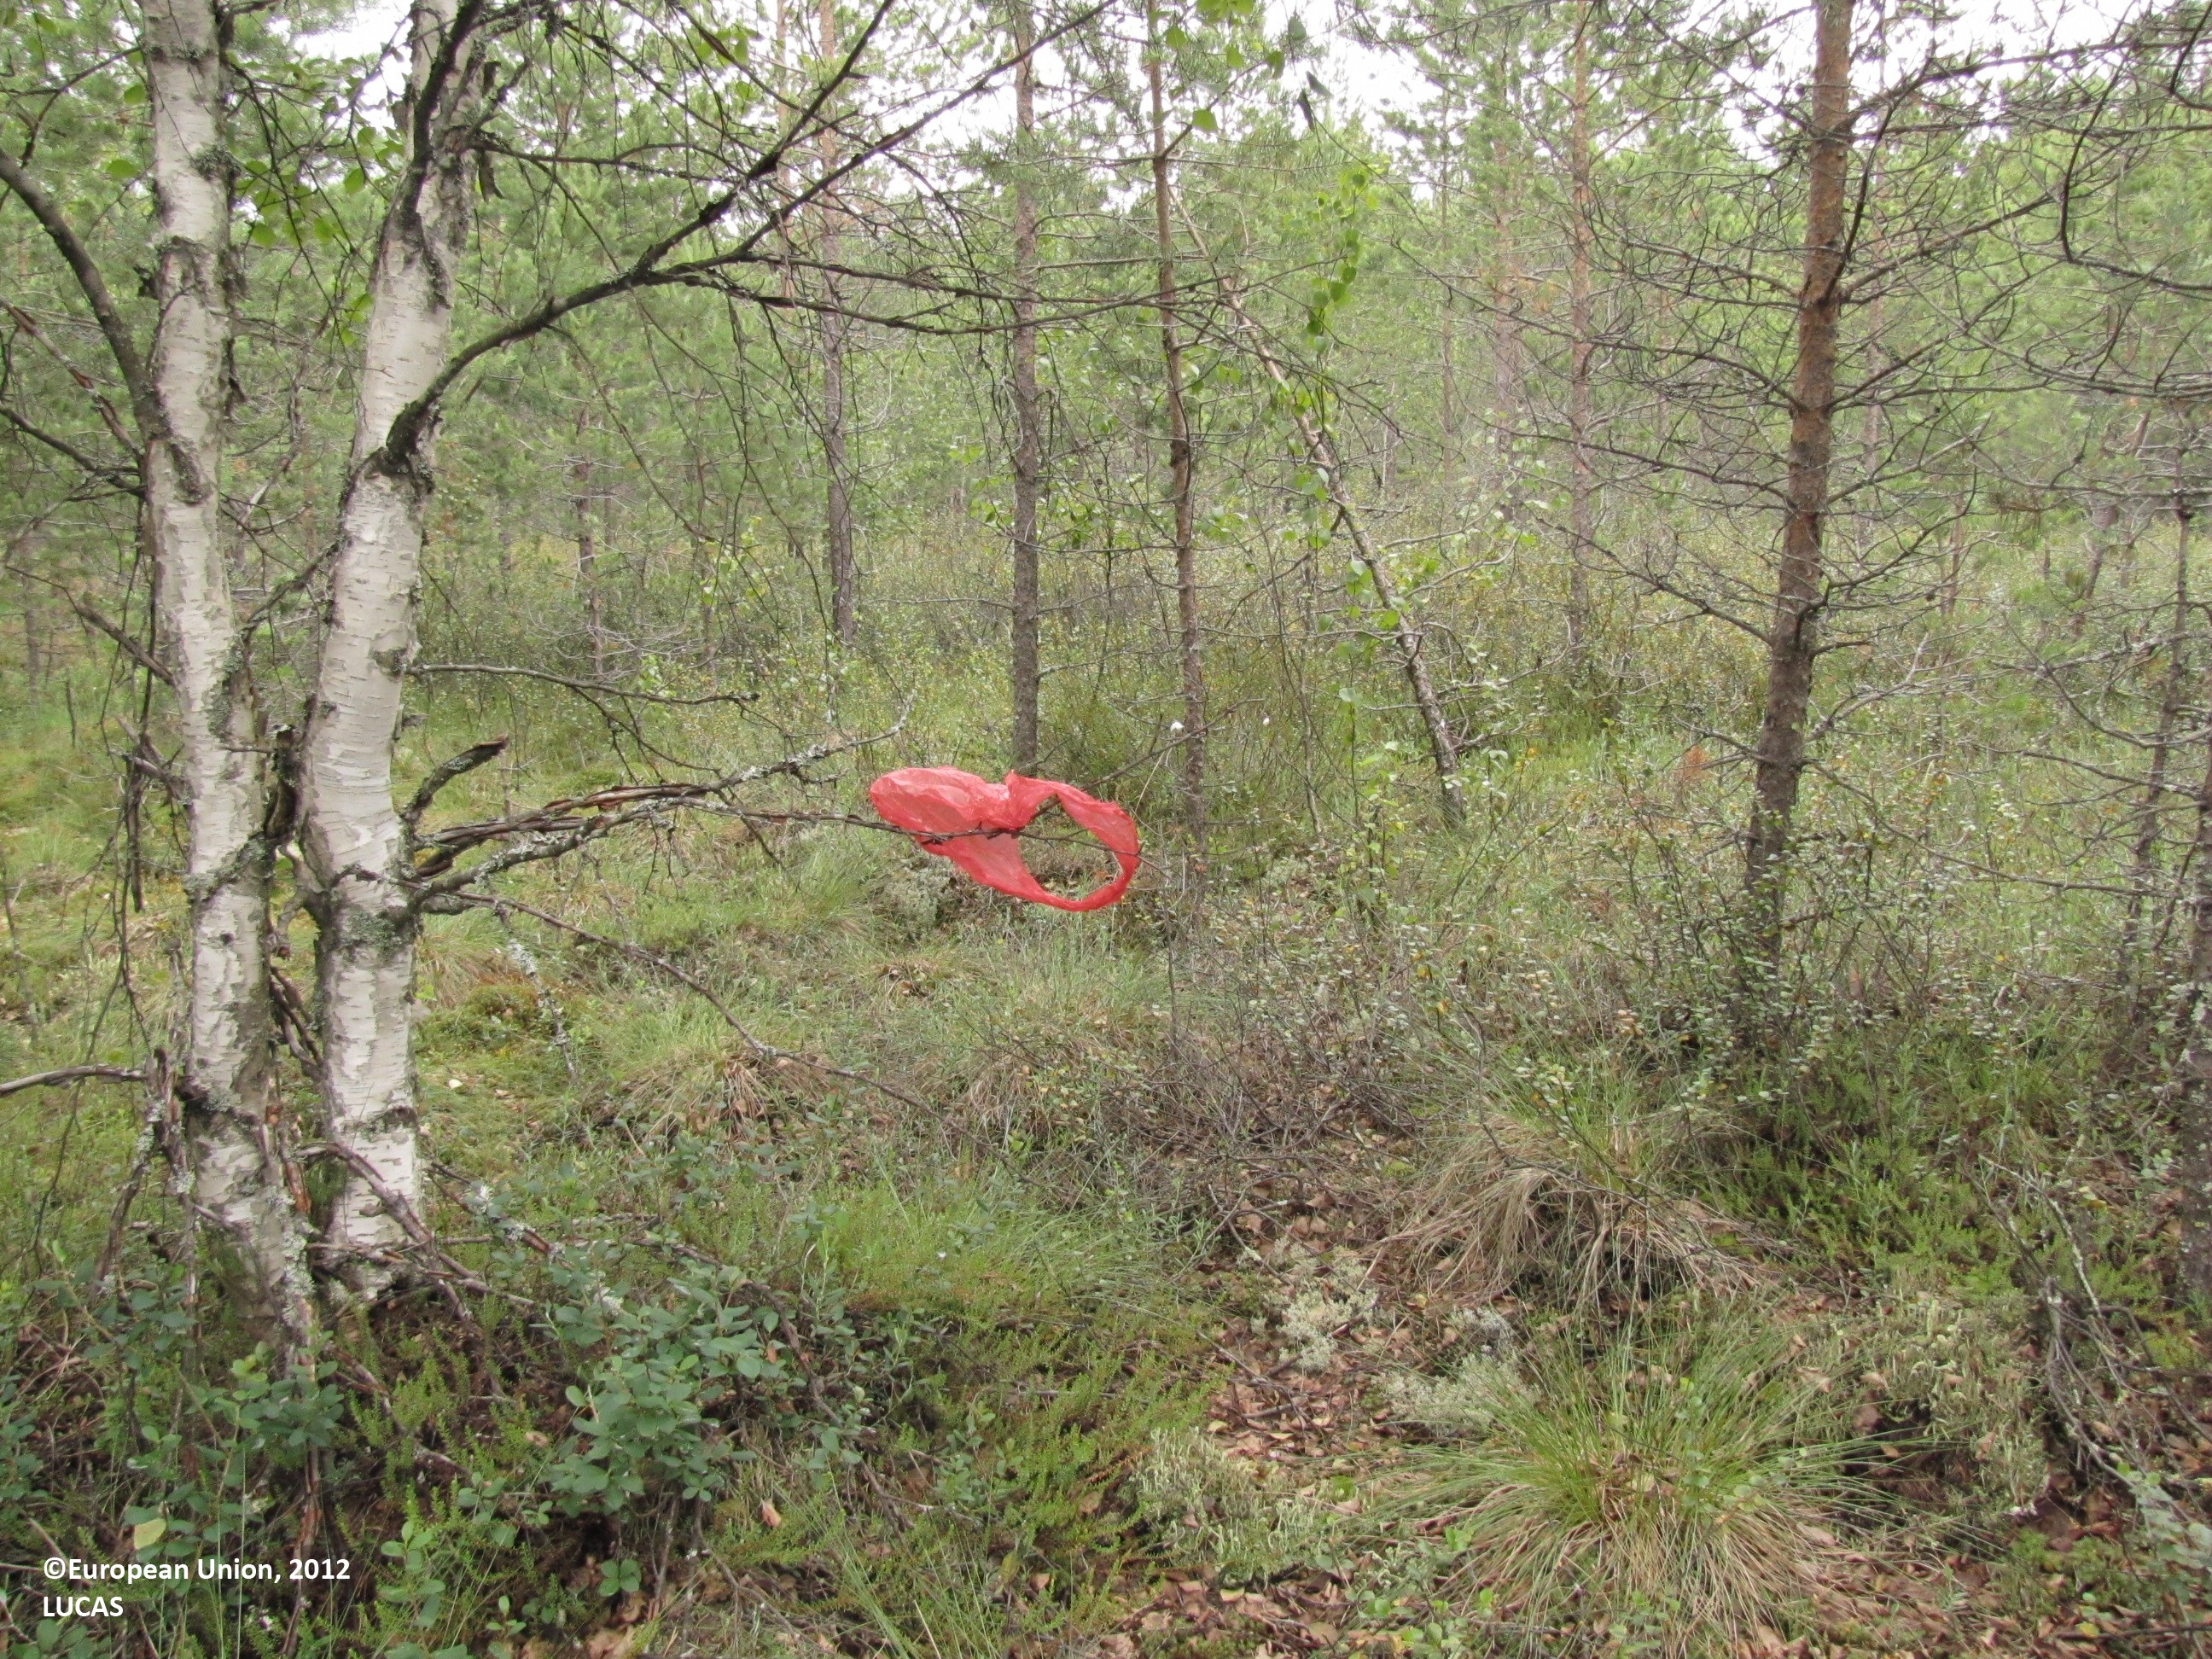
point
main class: Woodland
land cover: Pine dominated mixed woodland
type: mire and swamp forests
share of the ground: 25 - 50 %
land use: Forestry
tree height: > 5 m
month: July
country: FI
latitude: 62.2456
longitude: 23.0199
